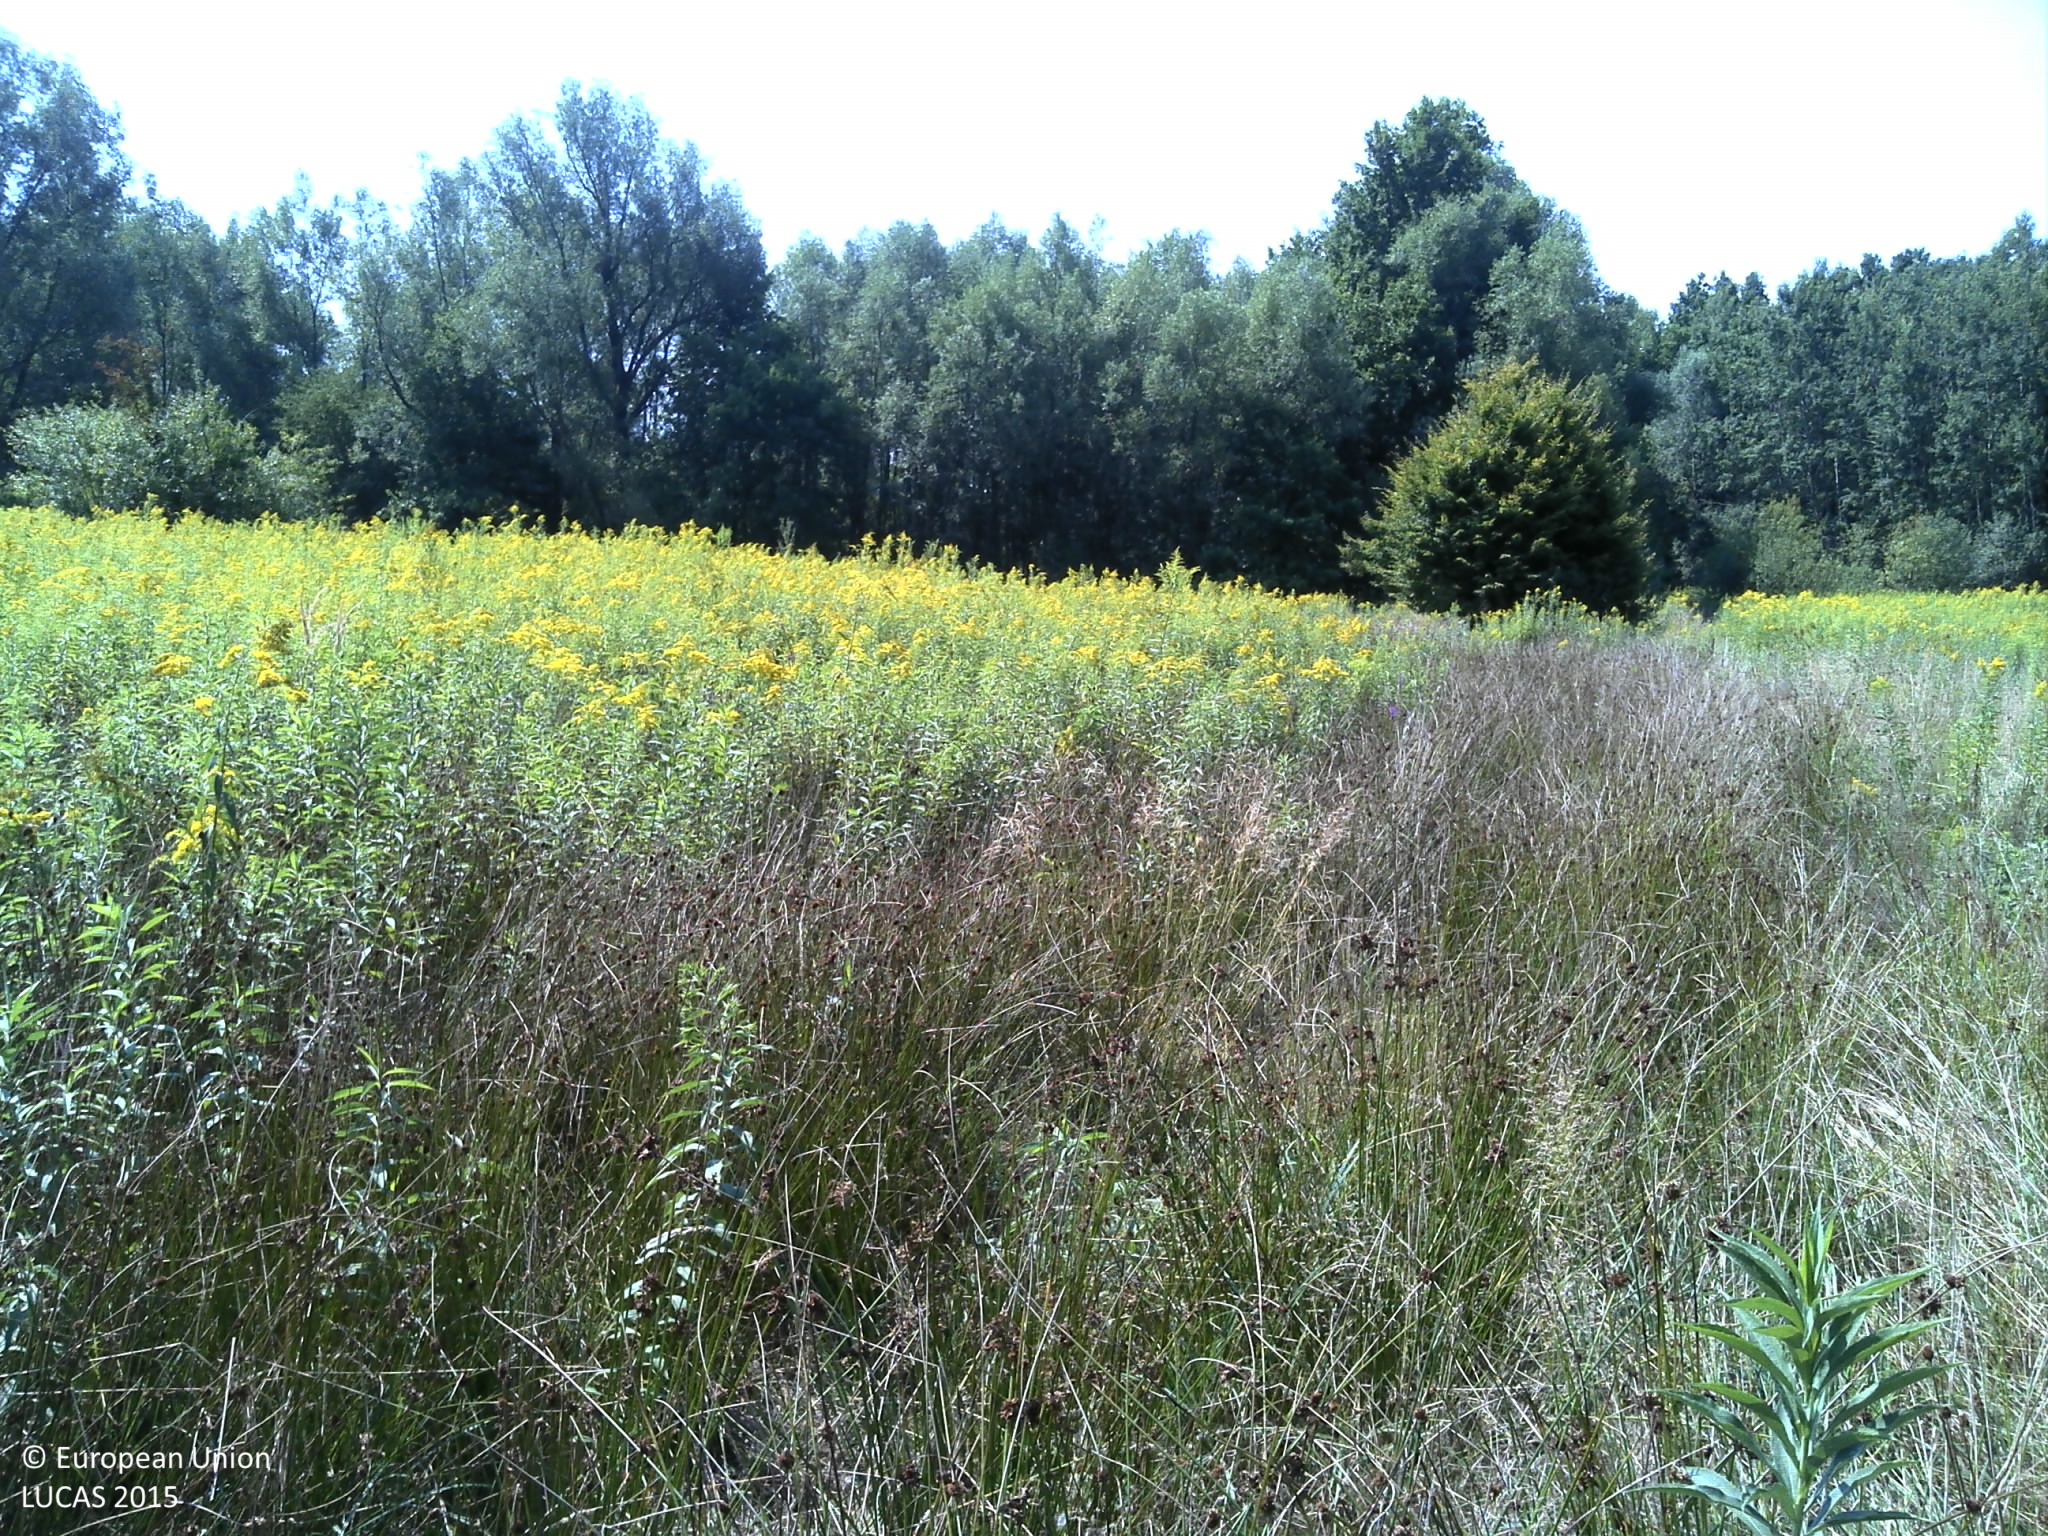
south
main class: Grassland
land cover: Spontaneously vegetated surfaces
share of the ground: > 75 %
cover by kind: herbaceous plants 100 %
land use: Agriculture (excluding fallow land and kitchen gardens)
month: August
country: HR
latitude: 45.5692
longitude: 16.8803
